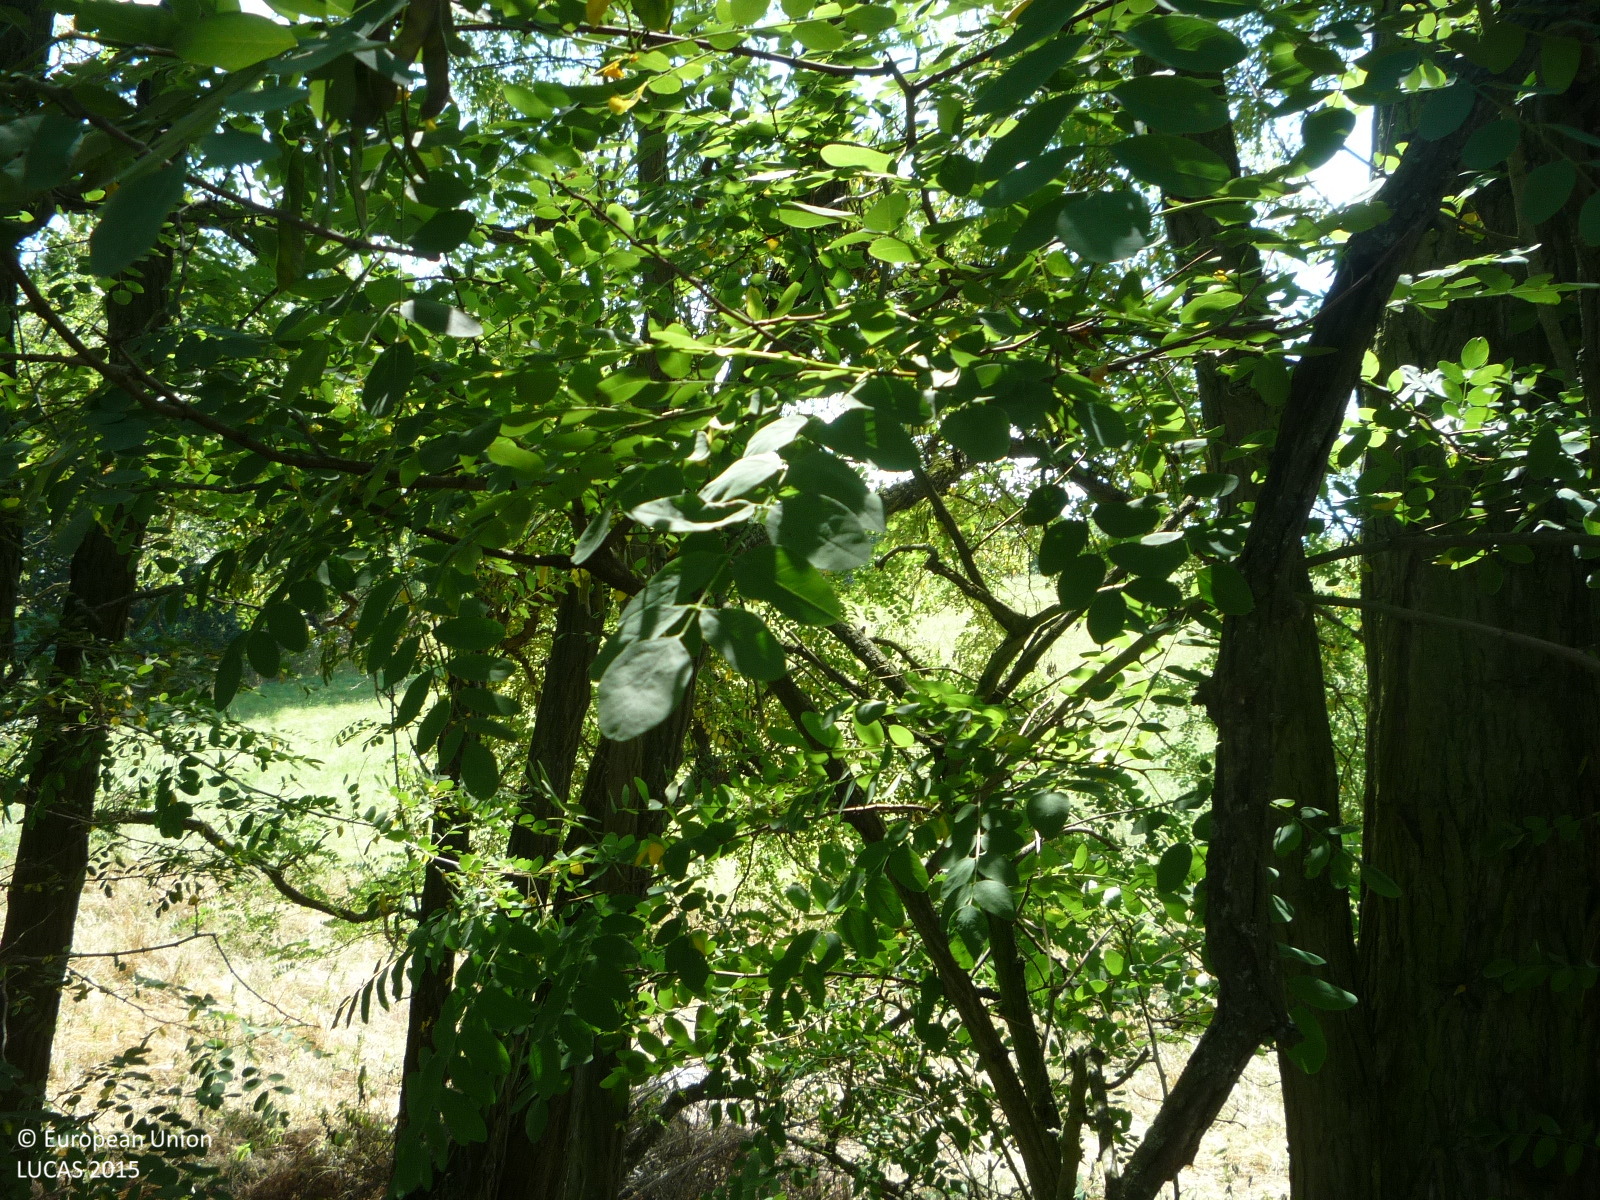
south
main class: Woodland
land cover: Broadleaved woodland
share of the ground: > 75 %
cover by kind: broadleaved forest trees 100 %
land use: Semi-natural and natural areas not in use
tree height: > 5 m
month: July
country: CZ
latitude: 50.5091
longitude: 14.9522
